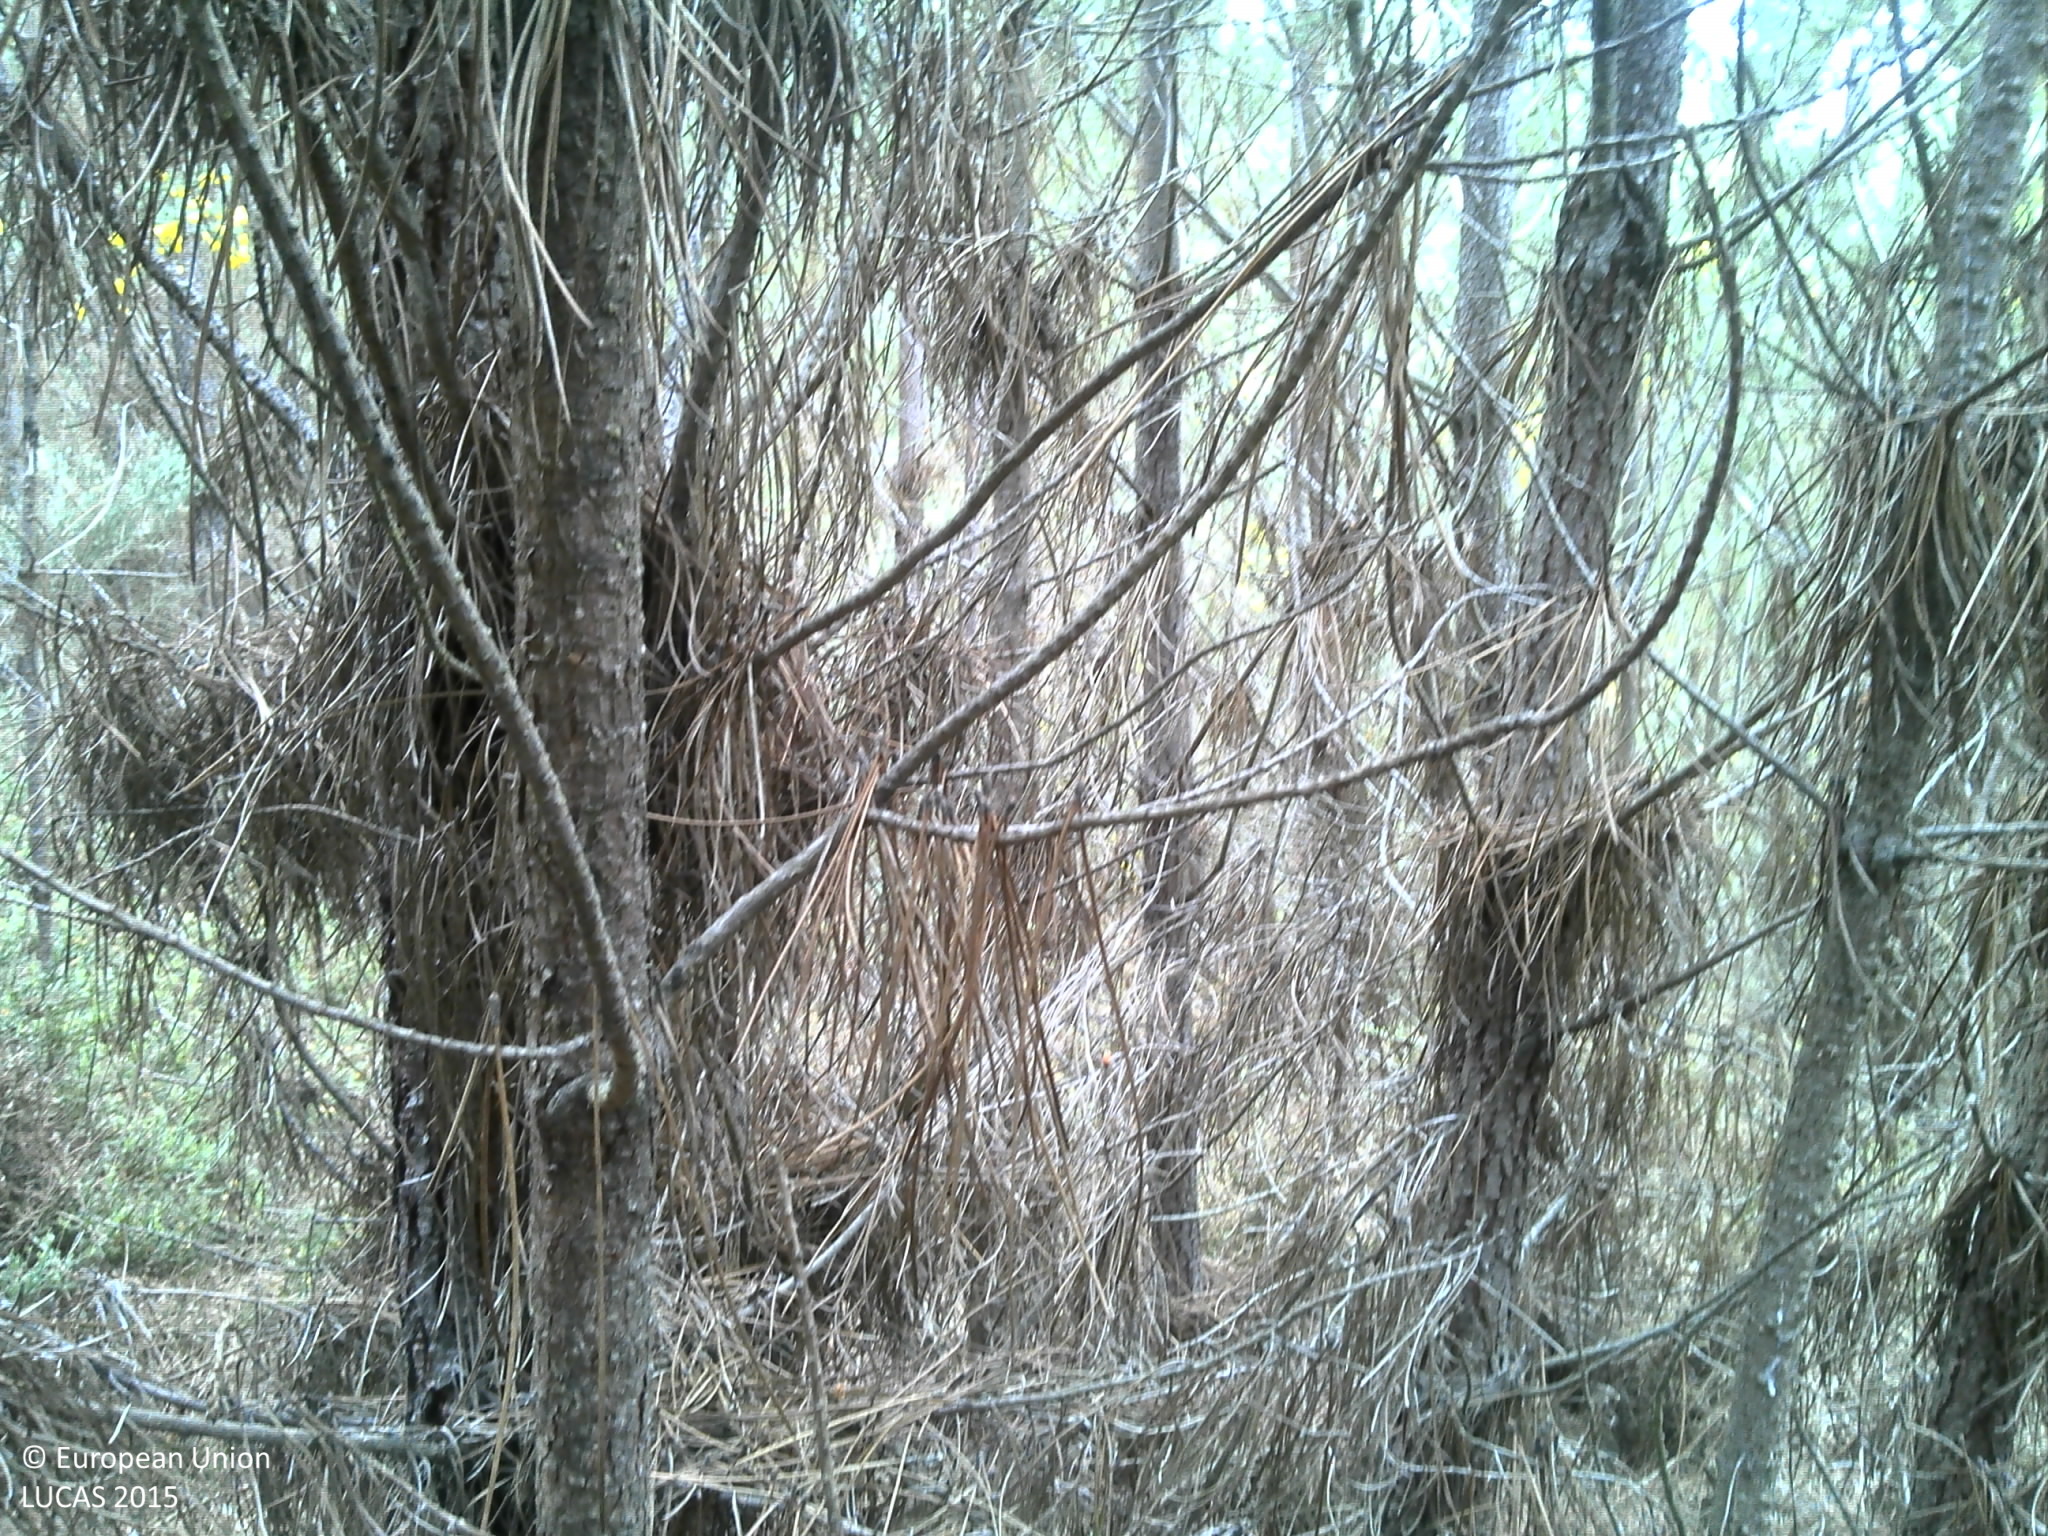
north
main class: Woodland
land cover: Pine dominated coniferous woodland
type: coniferous forest of the mediterranean region
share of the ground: > 75 %
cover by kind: coniferous forest trees 90 %, unconsolidated bare surface 10 %
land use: Forestry
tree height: > 5 m
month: May
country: PT
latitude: 41.6353
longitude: -6.9579
